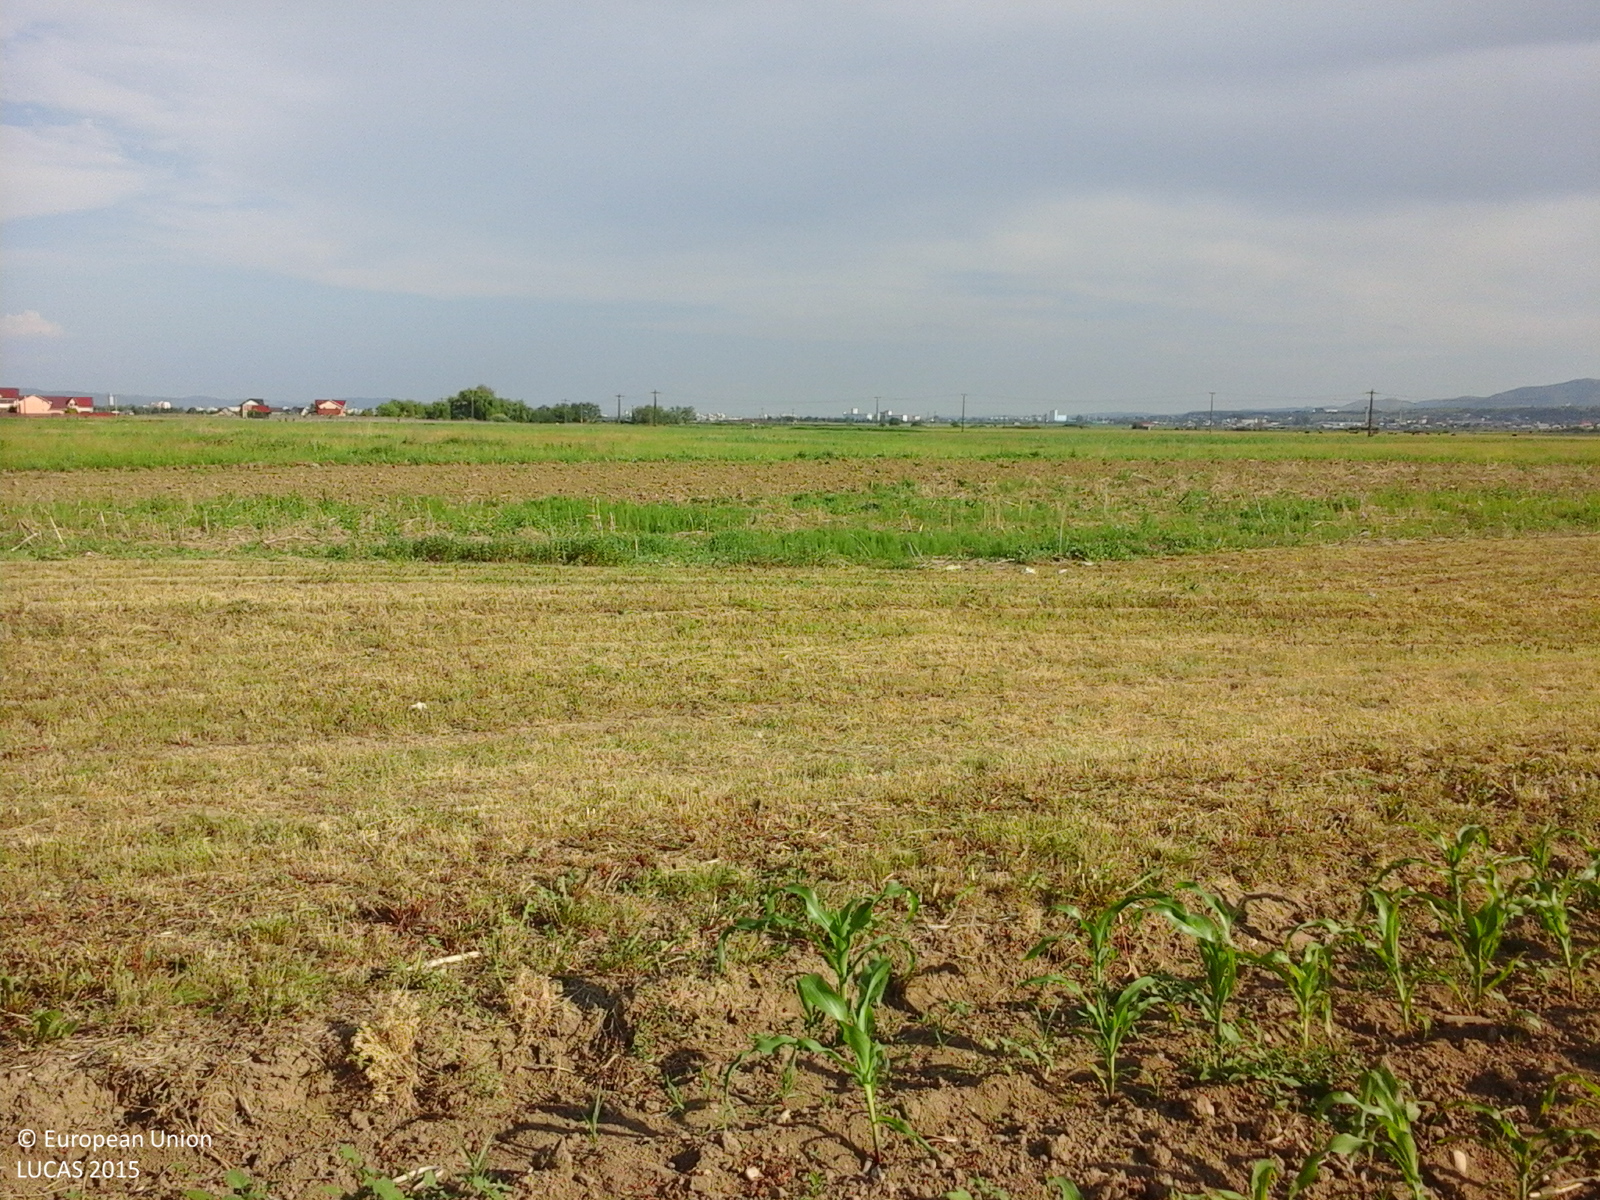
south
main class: Cropland
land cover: Maize
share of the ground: 10 - 25 %
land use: Agriculture (excluding fallow land and kitchen gardens)
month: June
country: RO
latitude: 46.6162
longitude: 26.8728
